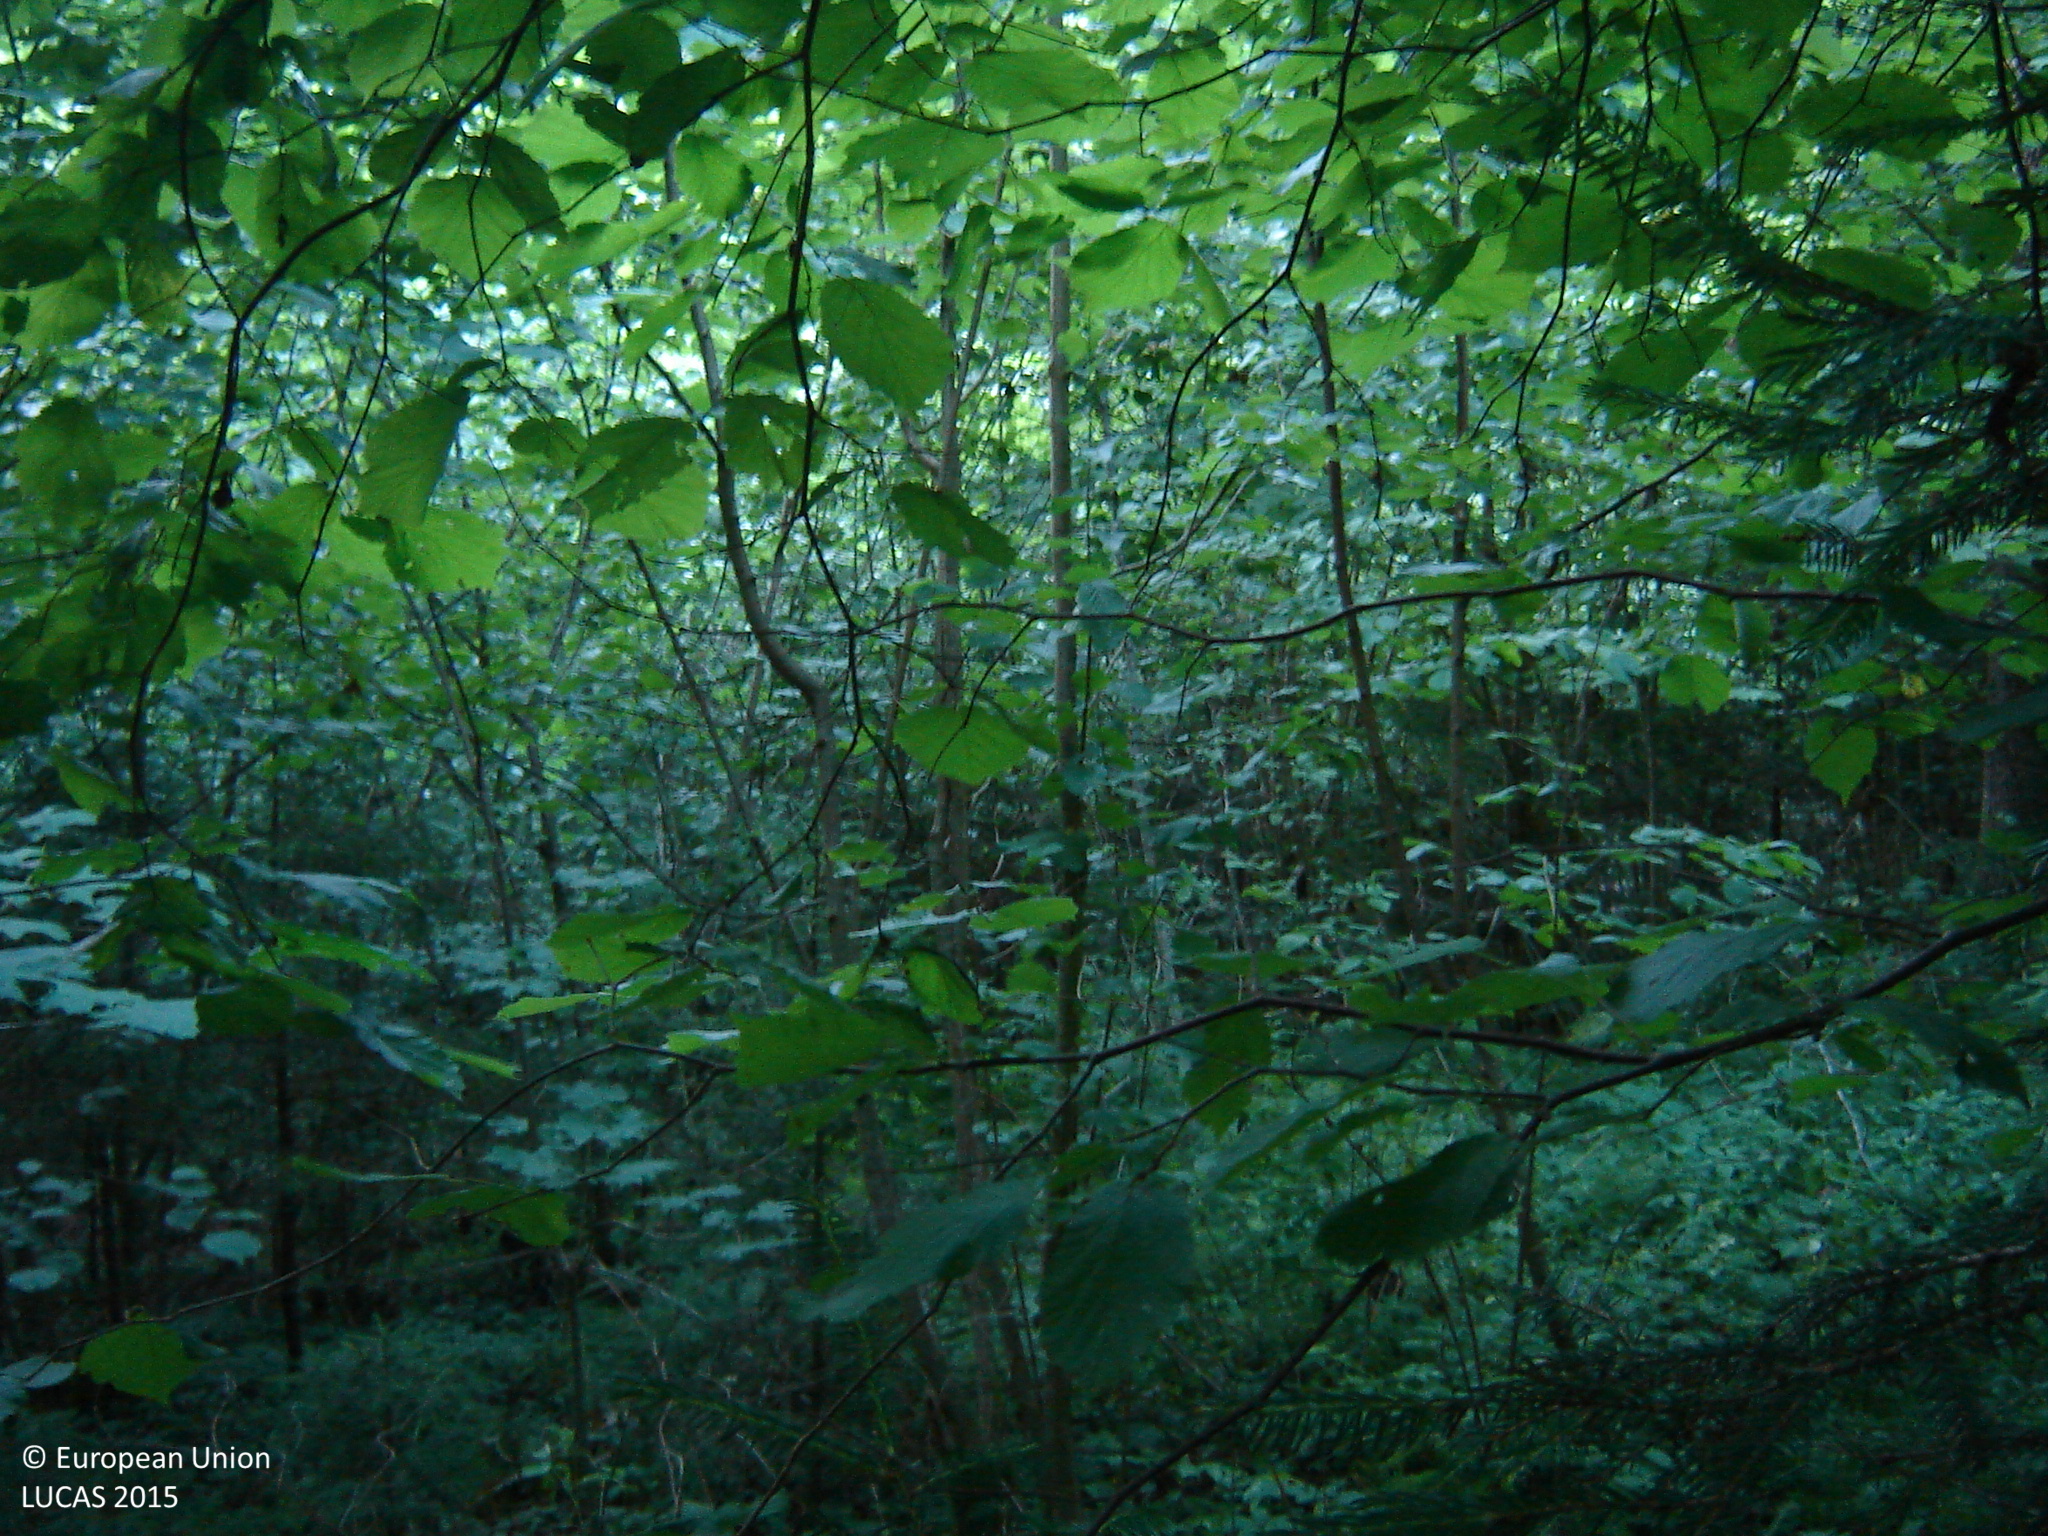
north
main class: Woodland
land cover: Broadleaved woodland
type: non-riverine alder, birch or aspen forest
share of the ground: > 75 %
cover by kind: broadleaved forest trees 85 %, coniferous forest trees 10 %, herbaceous plants 5 %
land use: Forestry
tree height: > 5 m
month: July
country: LT
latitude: 55.4918
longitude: 25.0705
